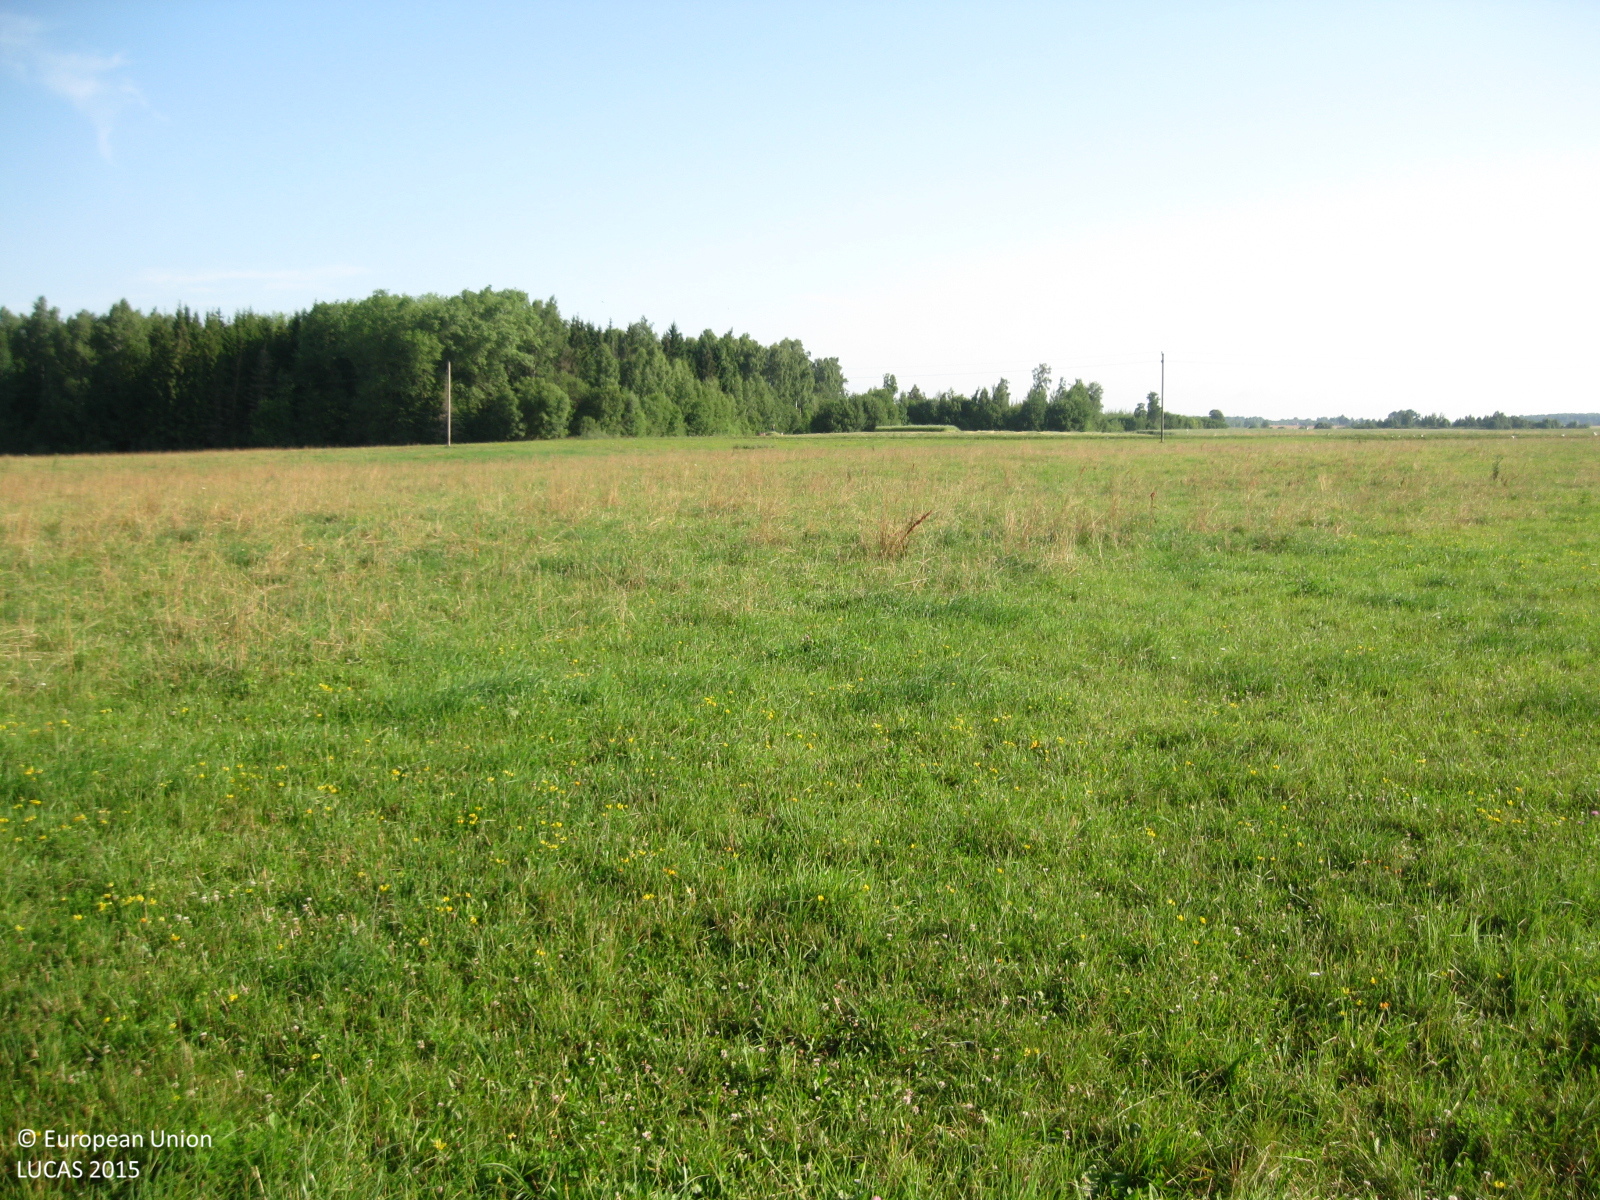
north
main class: Grassland
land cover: Grassland without tree/shrub cover
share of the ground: > 75 %
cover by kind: herbaceous plants 100 %
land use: Agriculture (excluding fallow land and kitchen gardens)
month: July
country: LT
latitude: 55.2767
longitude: 24.5690
